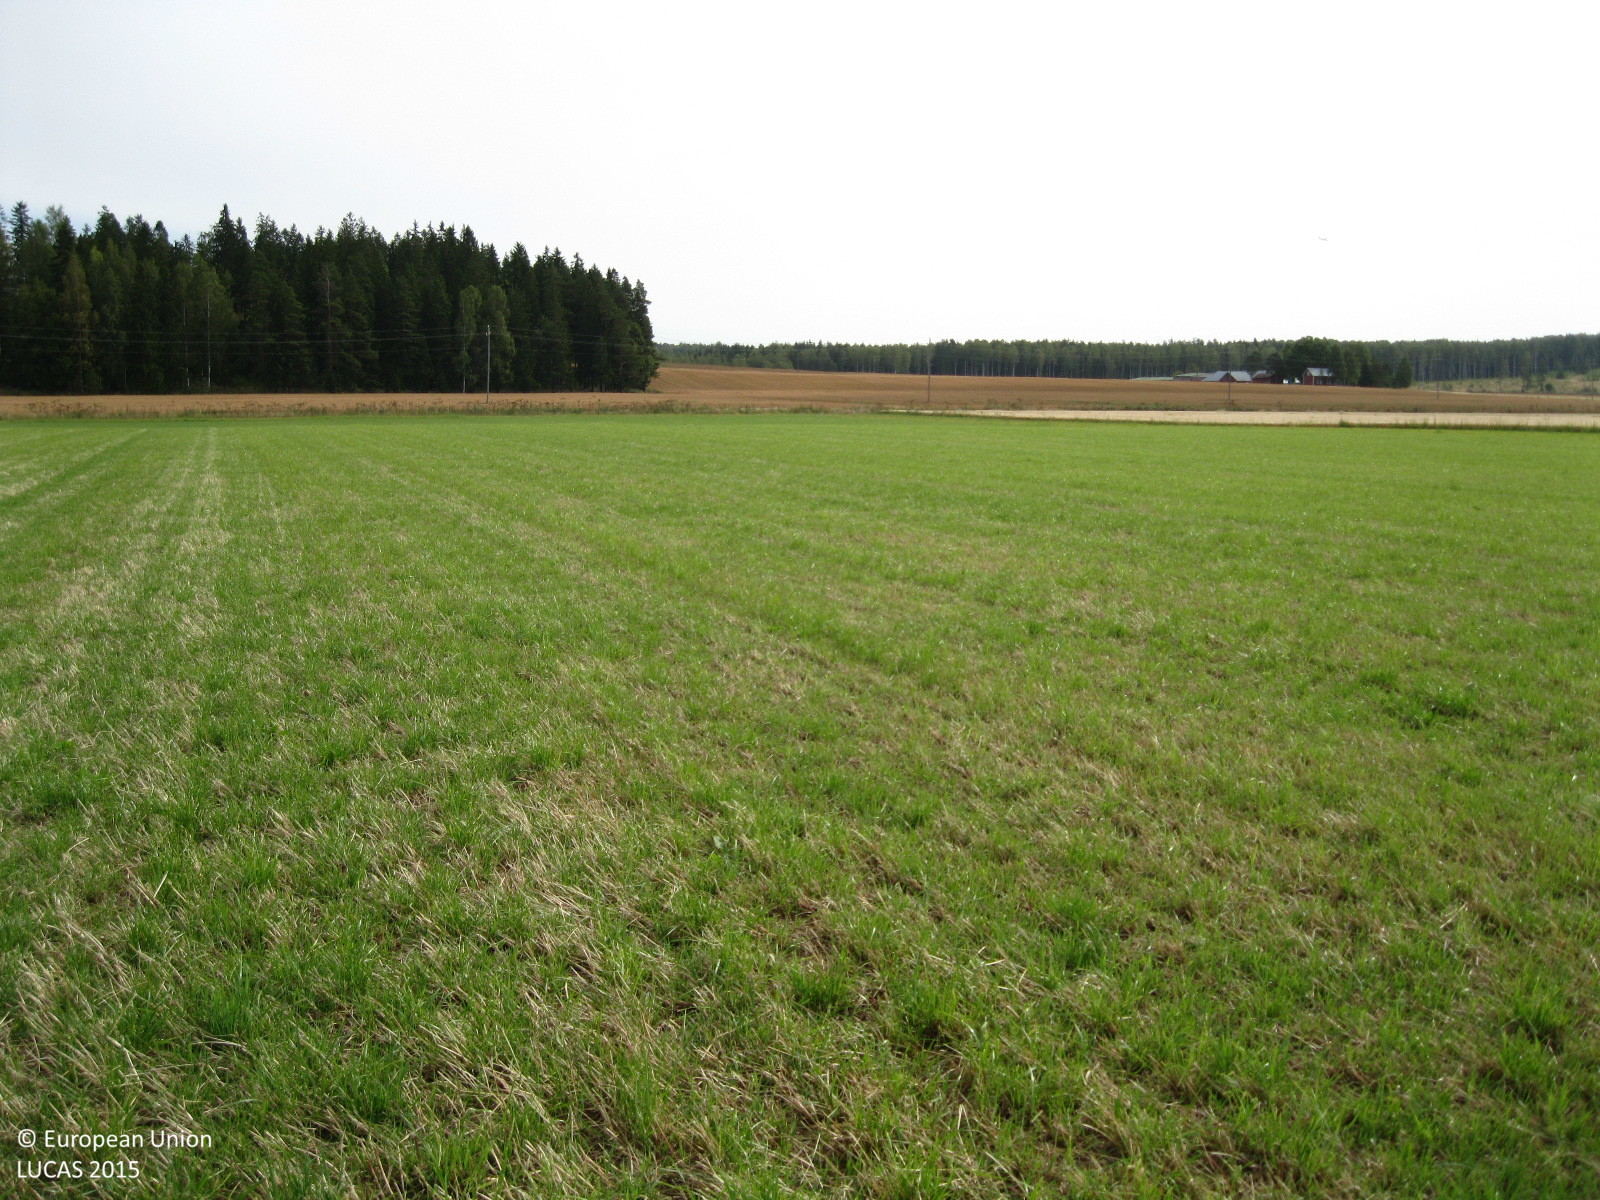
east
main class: Cropland
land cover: Temporary grasslands
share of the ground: > 75 %
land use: Agriculture (excluding fallow land and kitchen gardens)
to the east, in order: Temporary grasslands; Grassland without tree/shrub cover; Ditches and canals; Grass margins; Common wheat; Electric lines; Common wheat
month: September
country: FI
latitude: 60.3790
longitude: 24.8613
